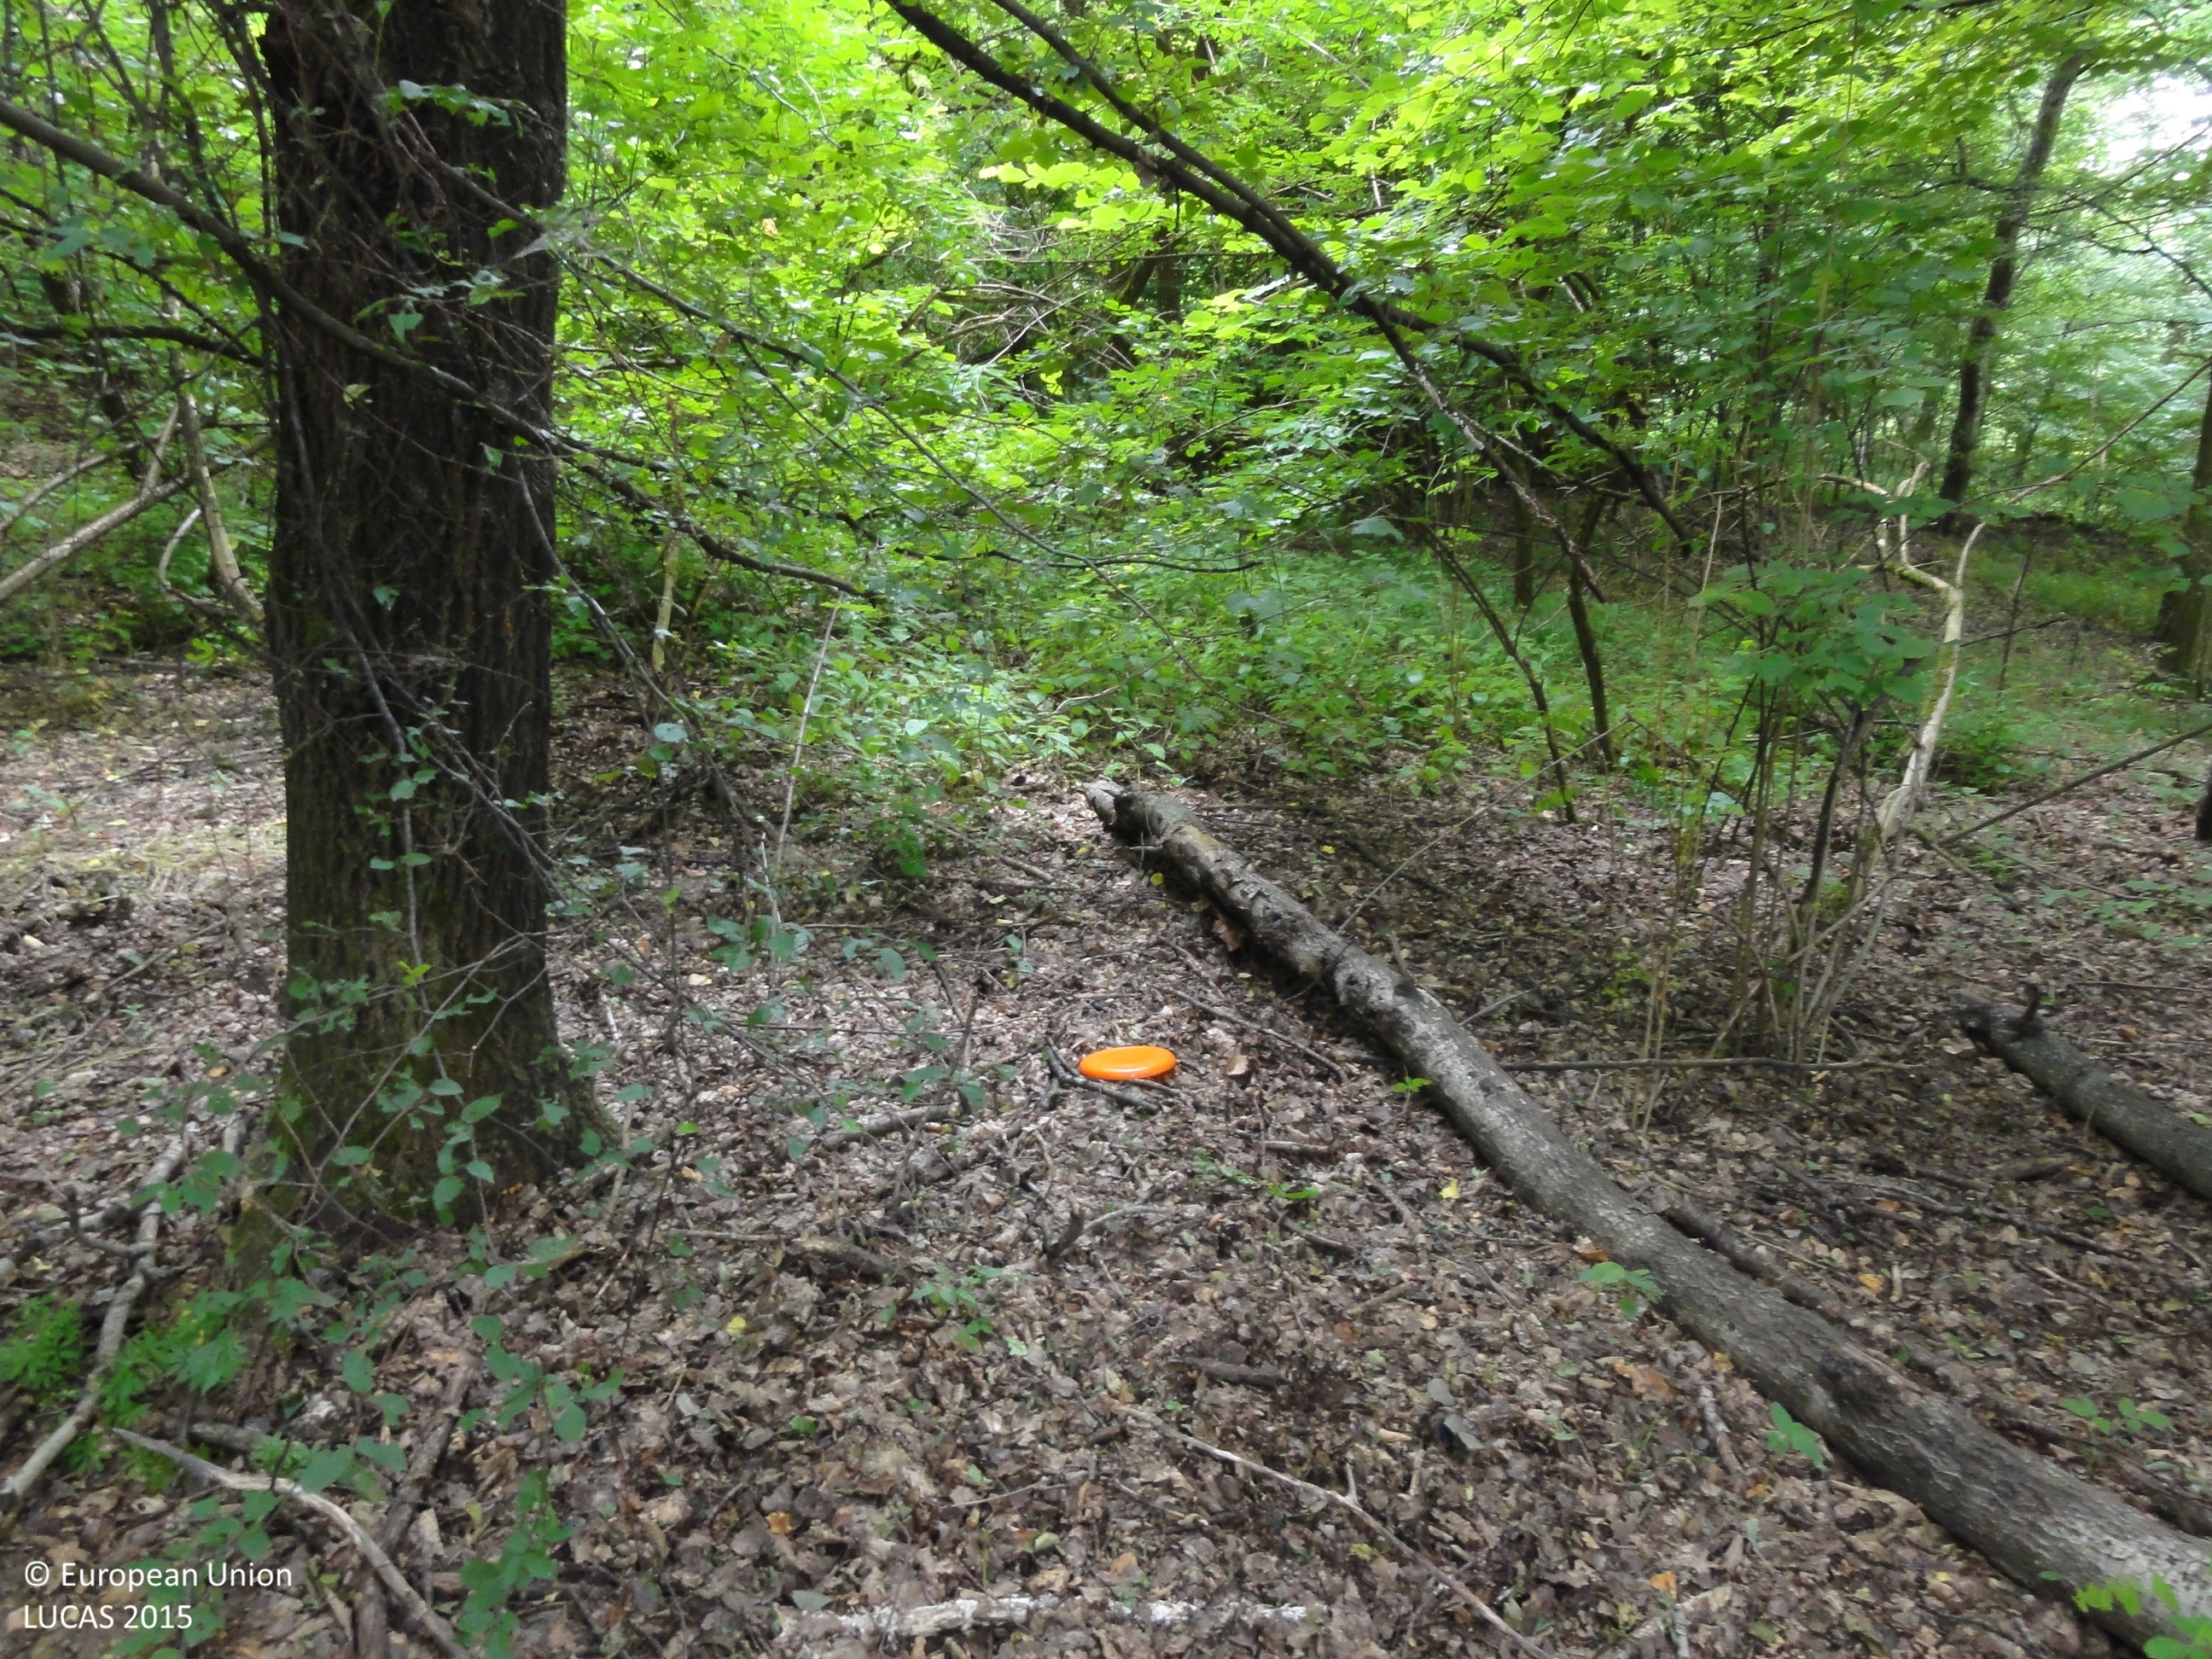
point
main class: Woodland
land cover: Broadleaved woodland
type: mesophytic deciduous forest
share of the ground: > 75 %
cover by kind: broadleaved forest trees 100 %
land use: Forestry
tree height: > 5 m
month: June
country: SI
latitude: 46.7317
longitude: 16.1905
